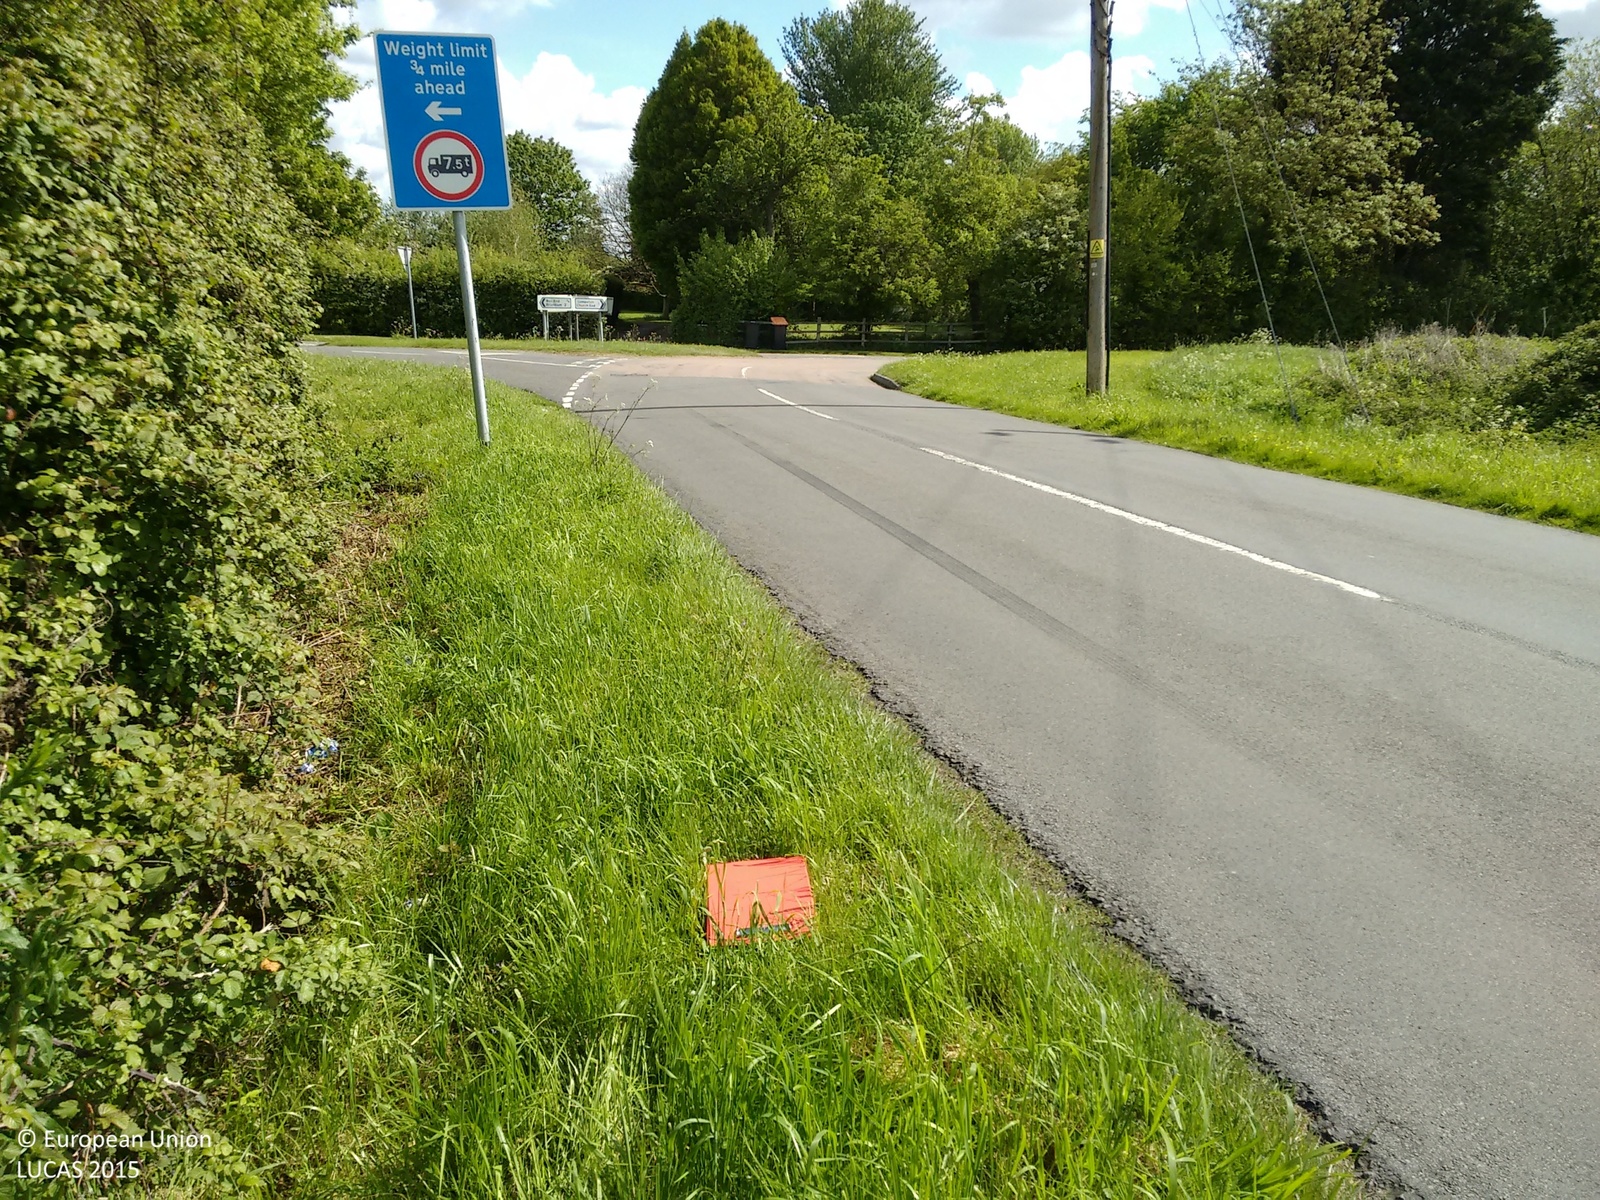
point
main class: Woodland
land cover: Broadleaved woodland
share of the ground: > 75 %
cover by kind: broadleaved forest trees 80 %, herbaceous plants 20 %
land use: Semi-natural and natural areas not in use
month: May
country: GB
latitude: 52.1244
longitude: -0.5408
